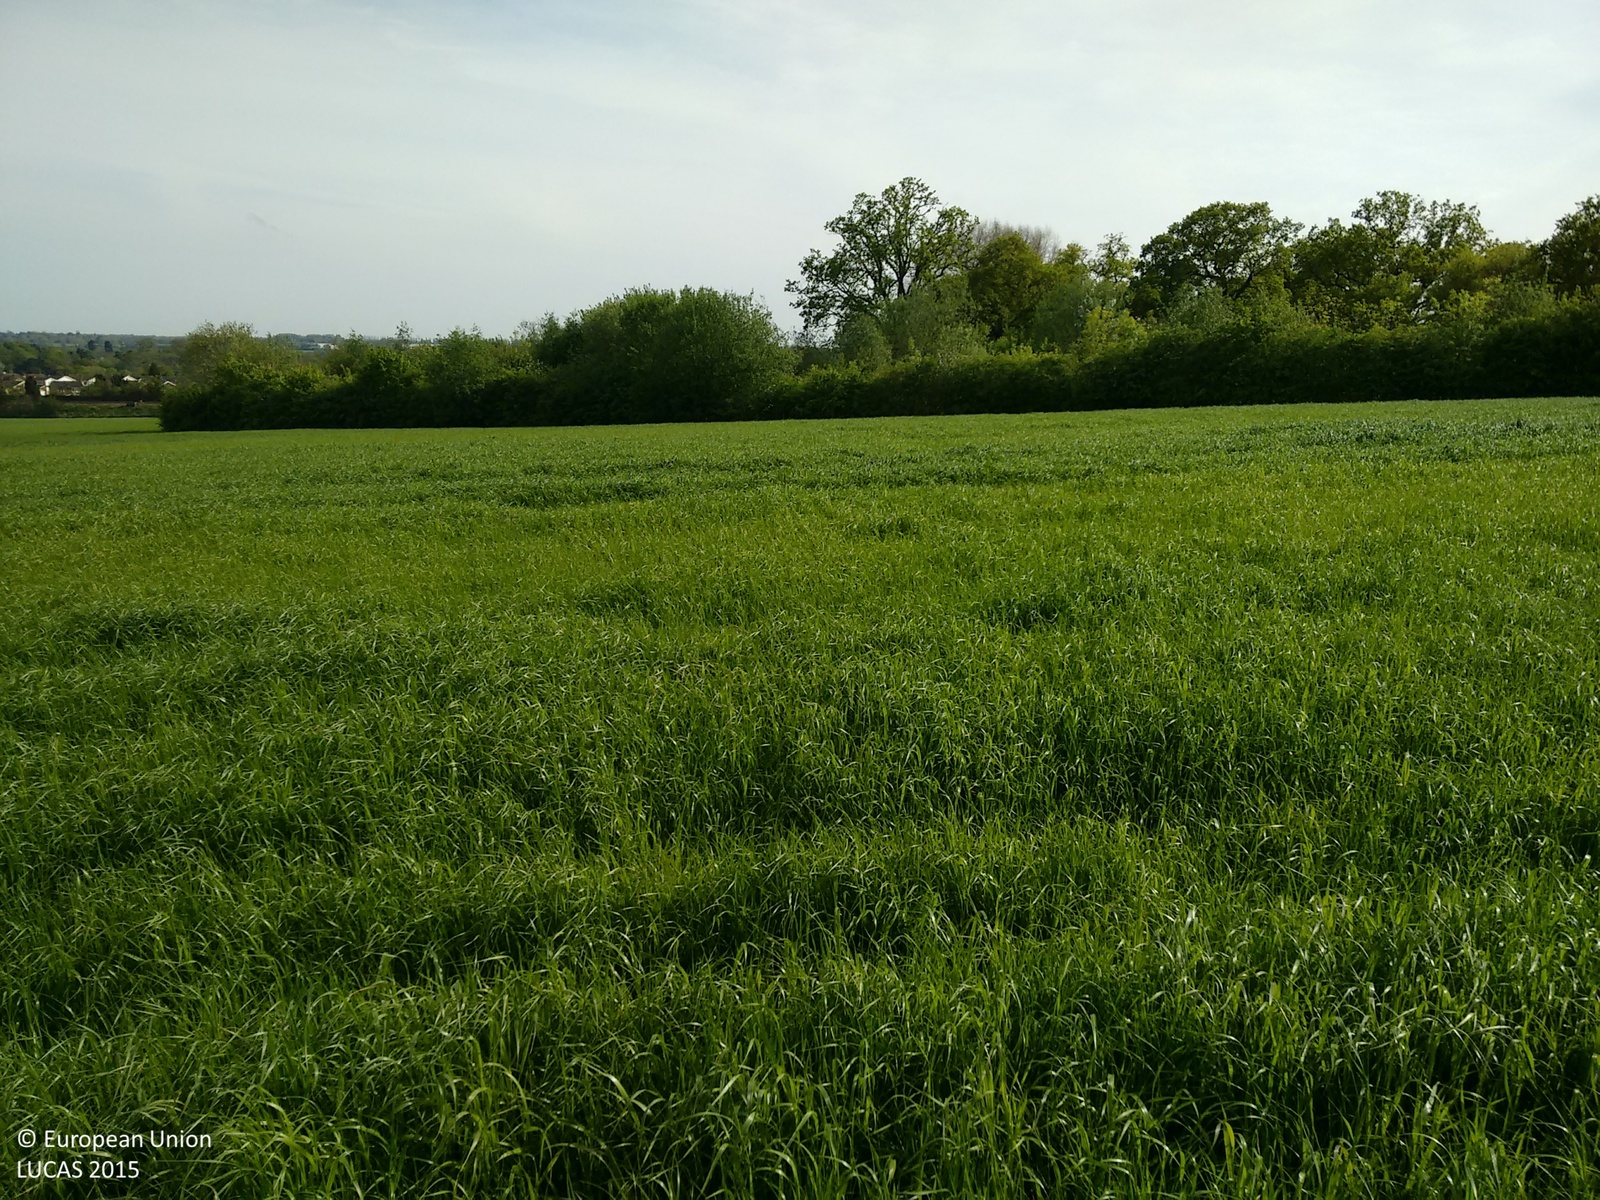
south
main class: Grassland
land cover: Grassland without tree/shrub cover
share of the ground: > 75 %
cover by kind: herbaceous plants 100 %
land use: Agriculture (excluding fallow land and kitchen gardens)
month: May
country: GB
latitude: 51.2783
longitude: 0.5829
